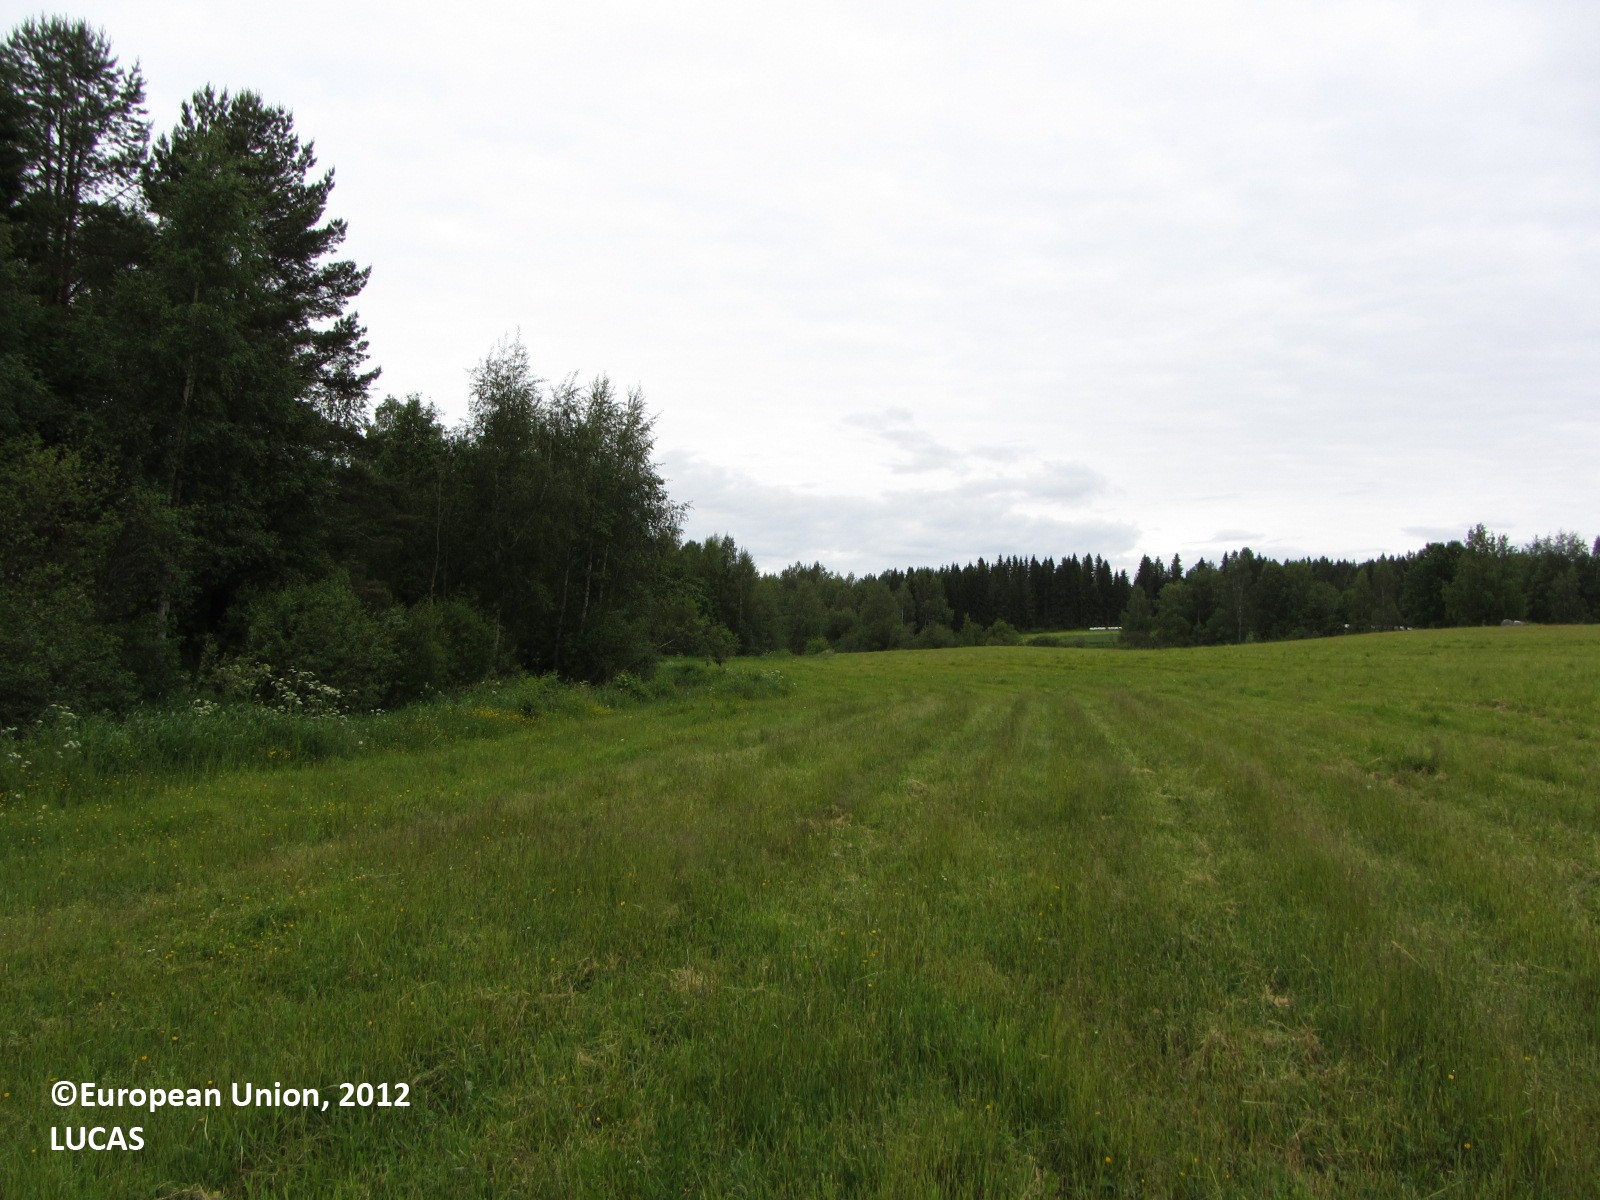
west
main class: Grassland
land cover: Grassland without tree/shrub cover
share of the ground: > 75 %
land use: Agriculture (excluding fallow land and kitchen gardens)
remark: Harvested field
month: June
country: FI
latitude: 62.6565
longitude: 25.2678
